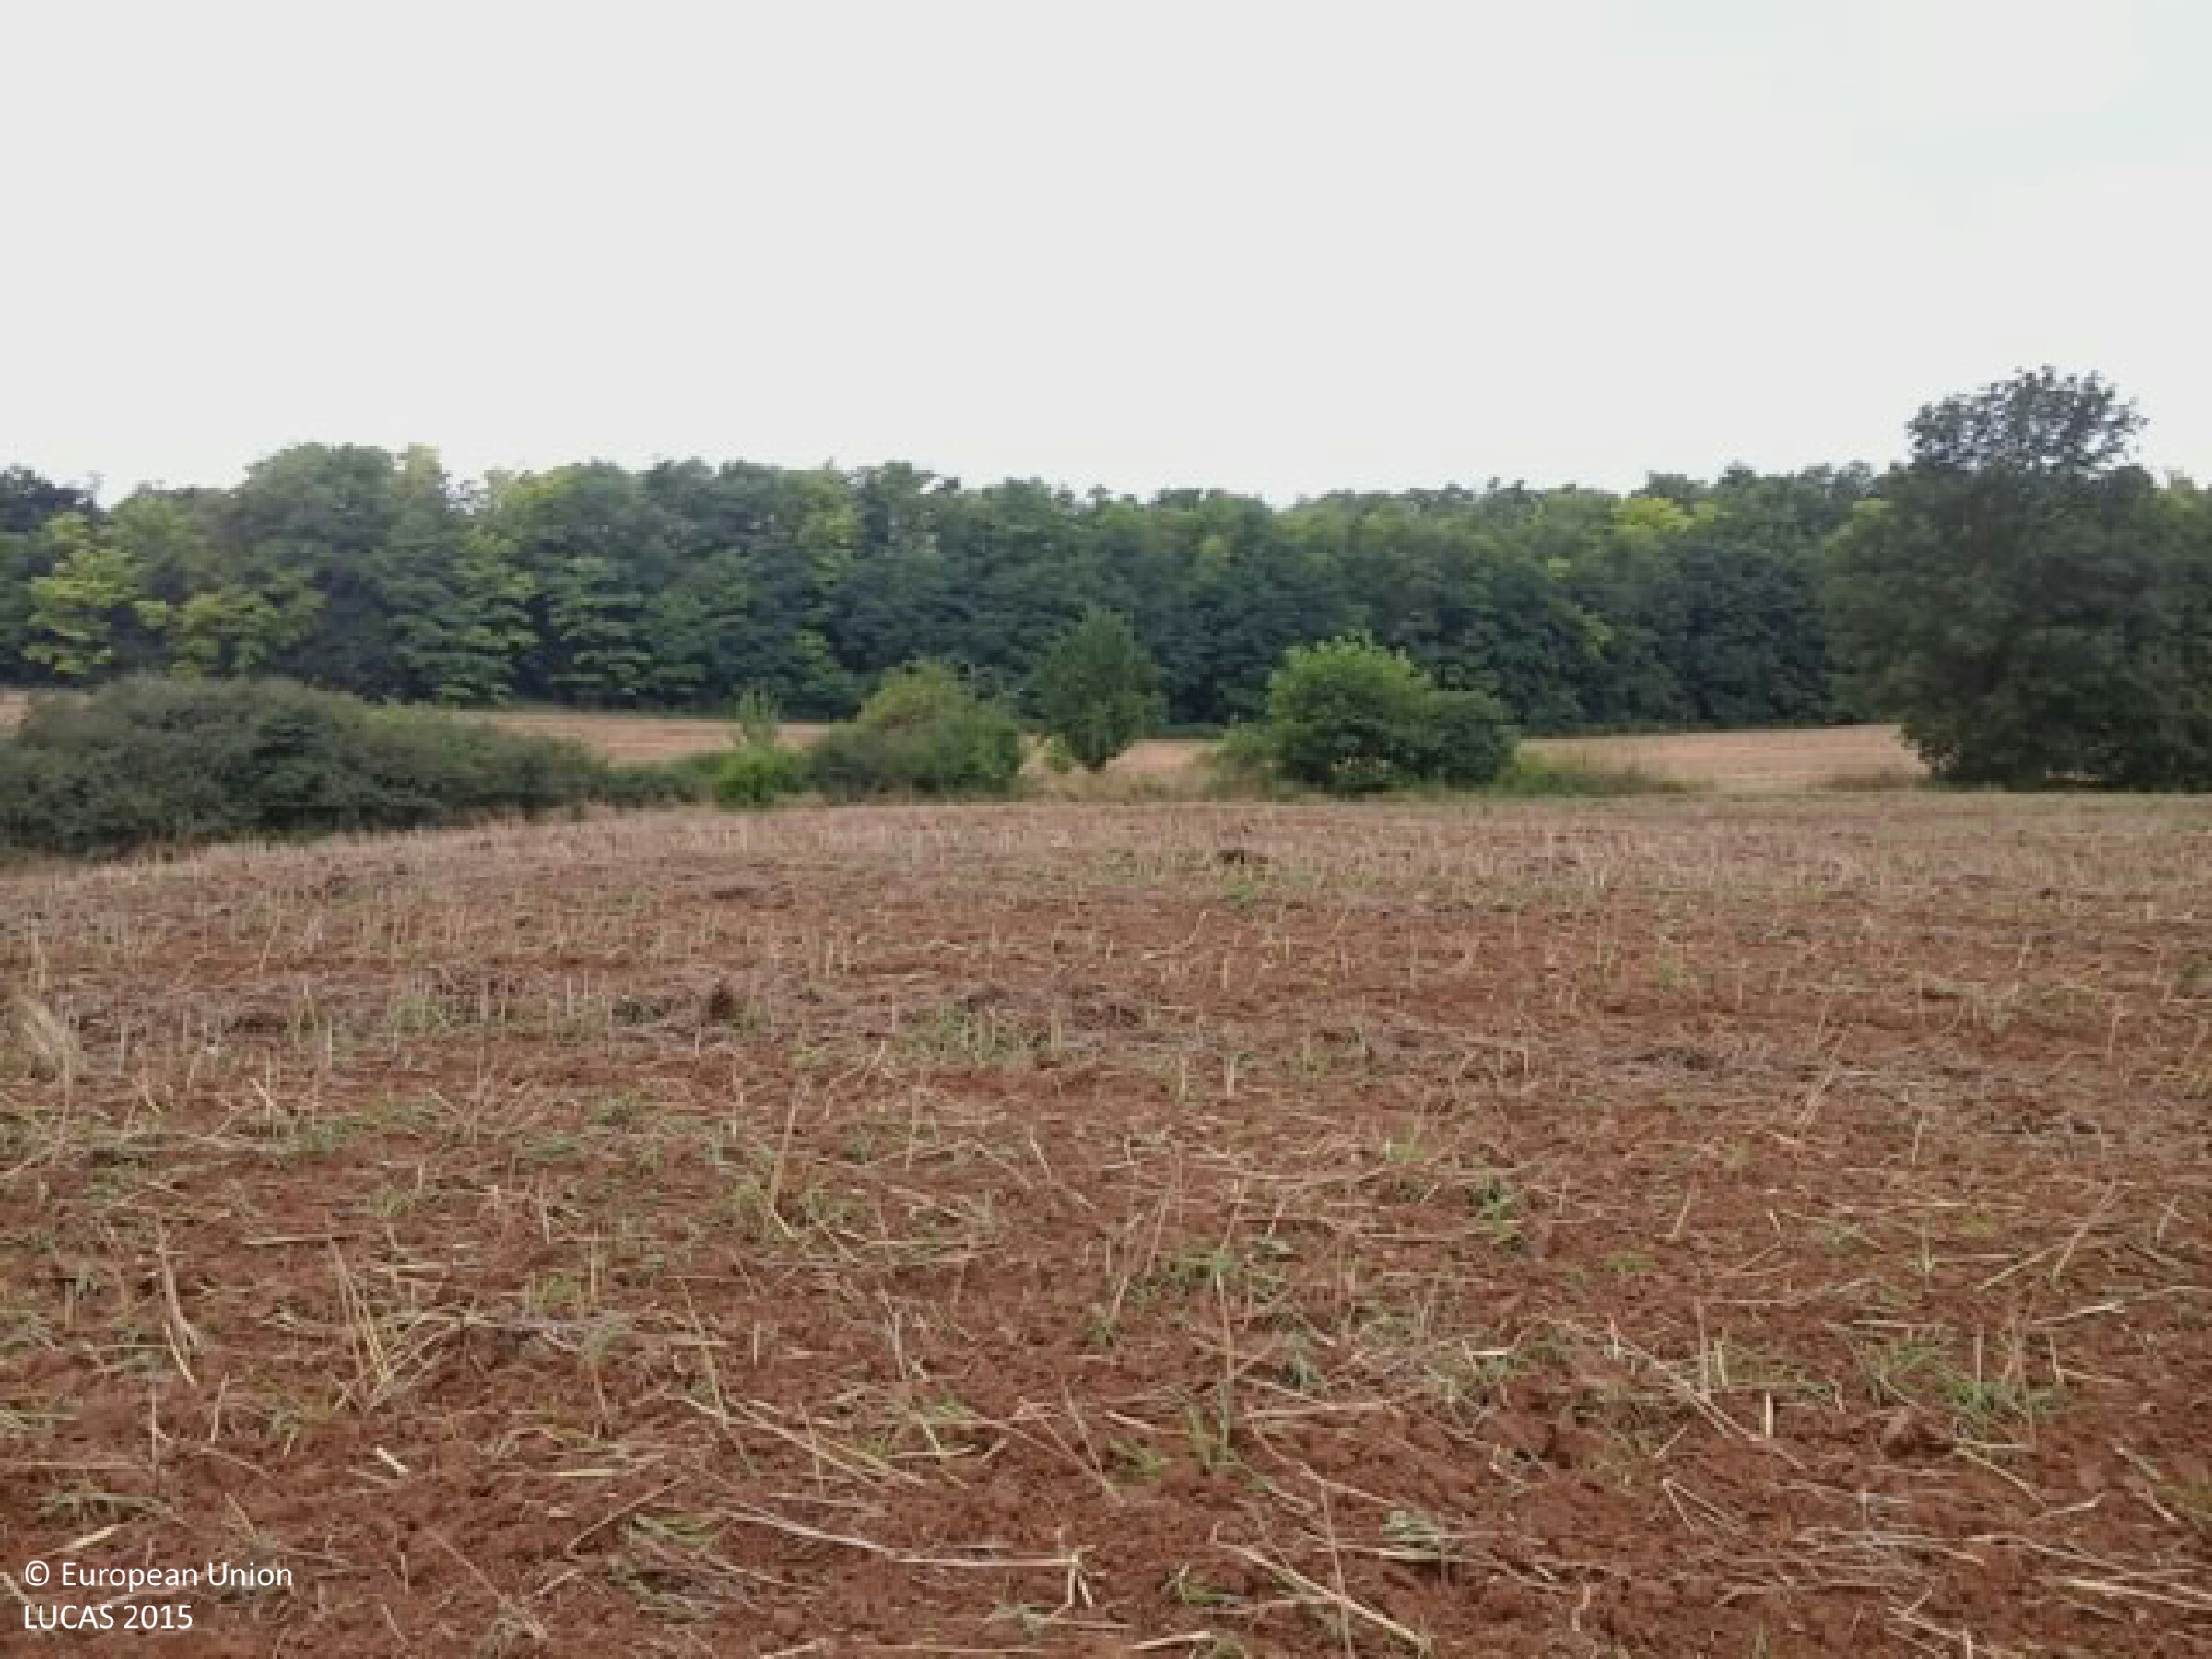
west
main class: Cropland
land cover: Rape and turnip rape
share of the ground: > 75 %
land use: Agriculture (excluding fallow land and kitchen gardens)
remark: Harvested field
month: July
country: HU
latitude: 46.2534
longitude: 17.9580
